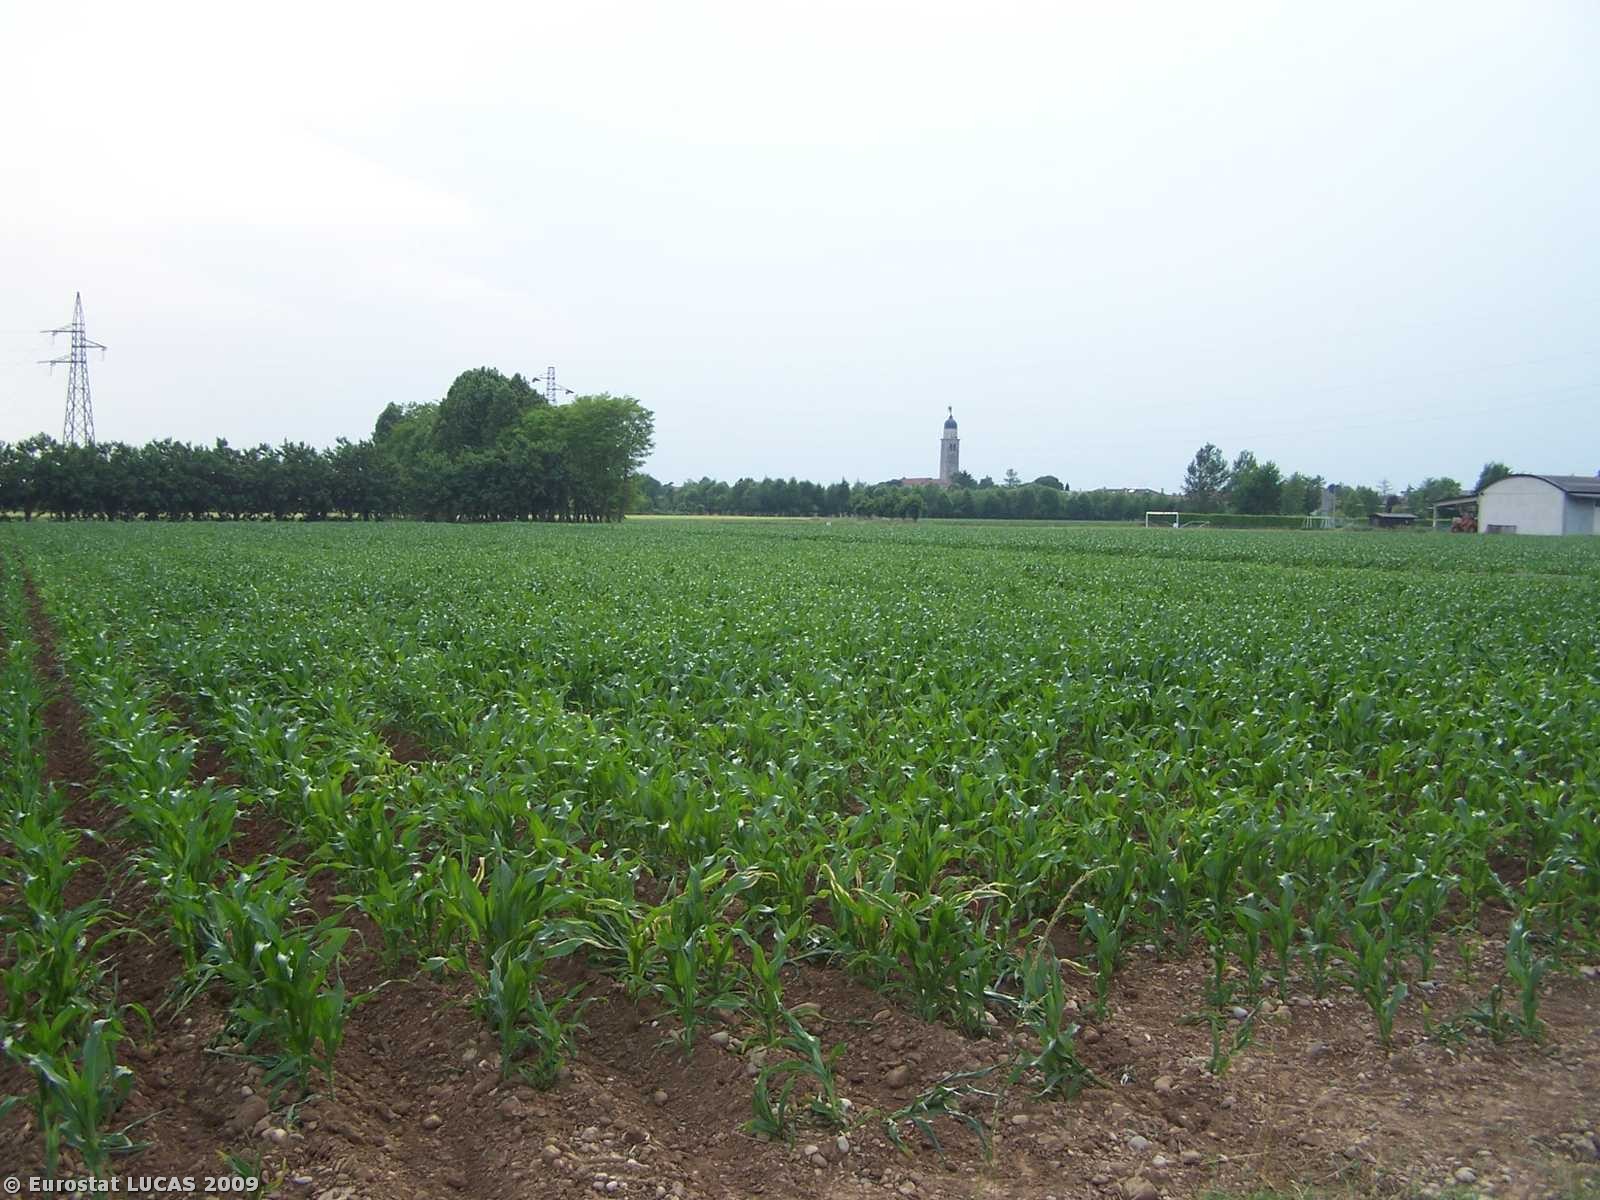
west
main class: Cropland
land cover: Maize
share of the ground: 50 - 75 %
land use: Agriculture (excluding fallow land and kitchen gardens)
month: May
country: IT
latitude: 45.9853
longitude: 12.9784
